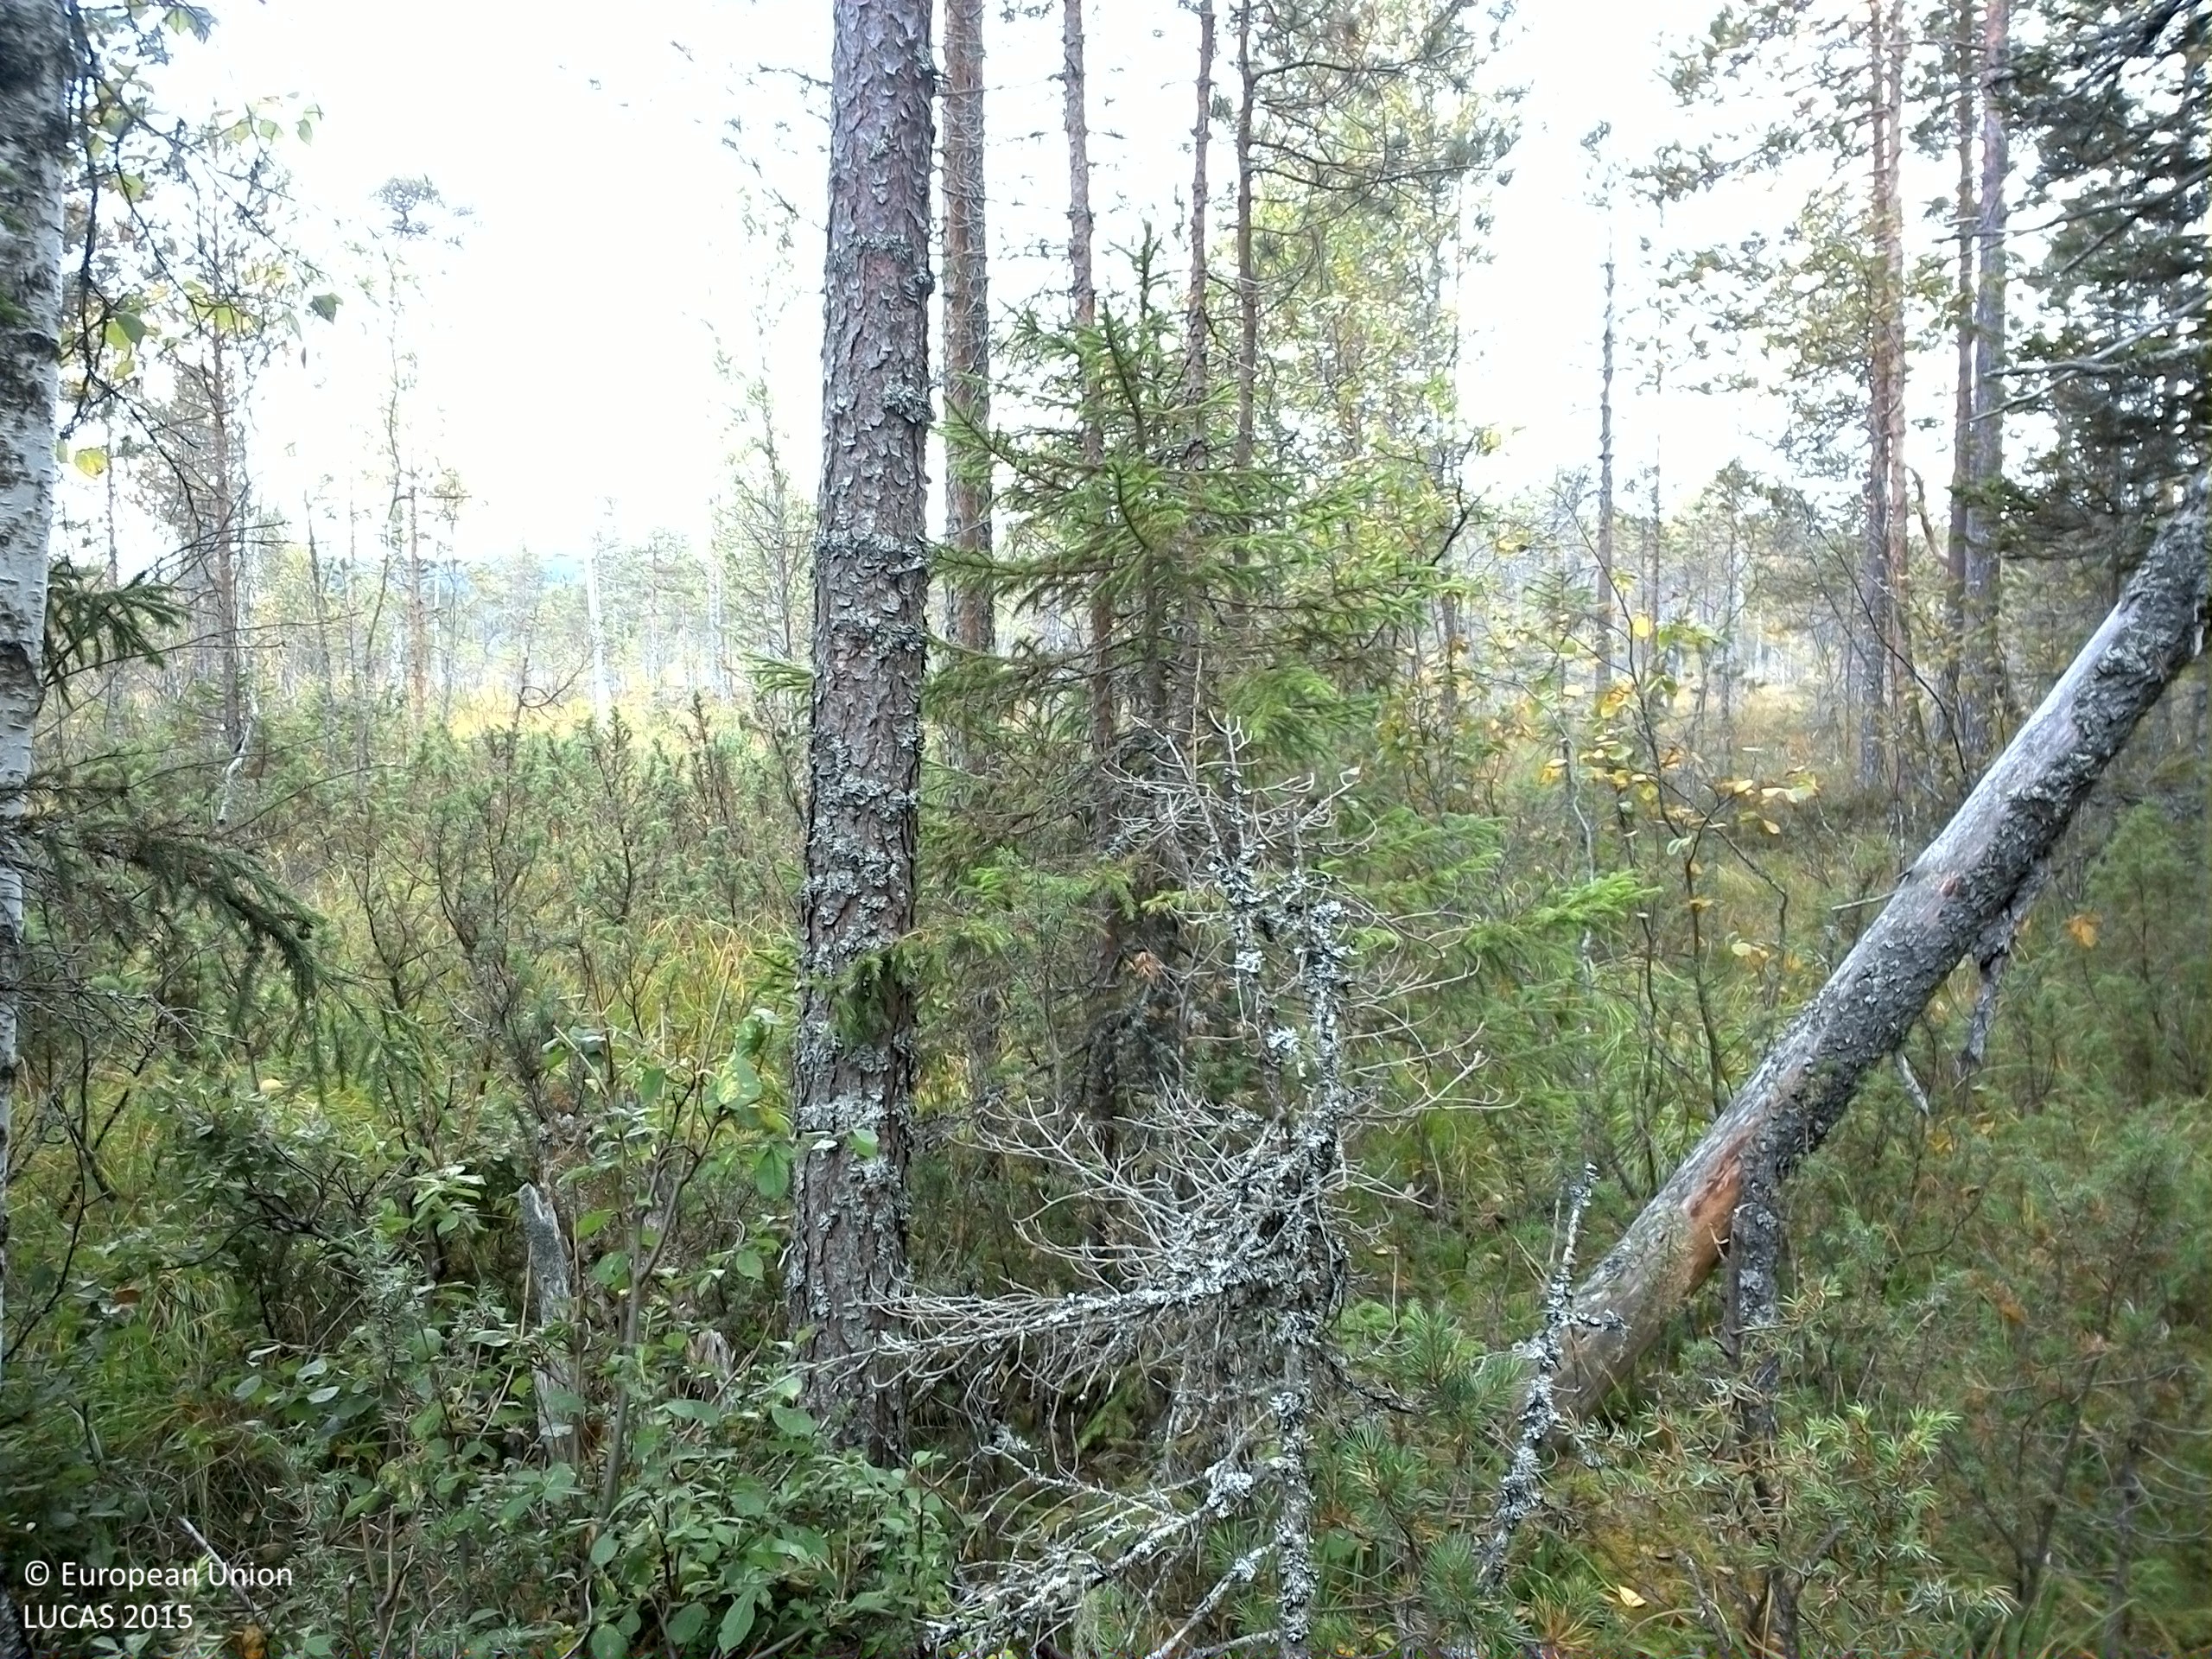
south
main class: Woodland
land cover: Pine dominated mixed woodland
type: boreal forest
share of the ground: 50 - 75 %
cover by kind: coniferous forest trees 45 %, broadleaved forest trees 20 %, lichens and mosses 20 %, shrubs 15 %
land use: Forestry
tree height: > 5 m
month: September
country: SE
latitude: 61.5485
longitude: 15.1584
